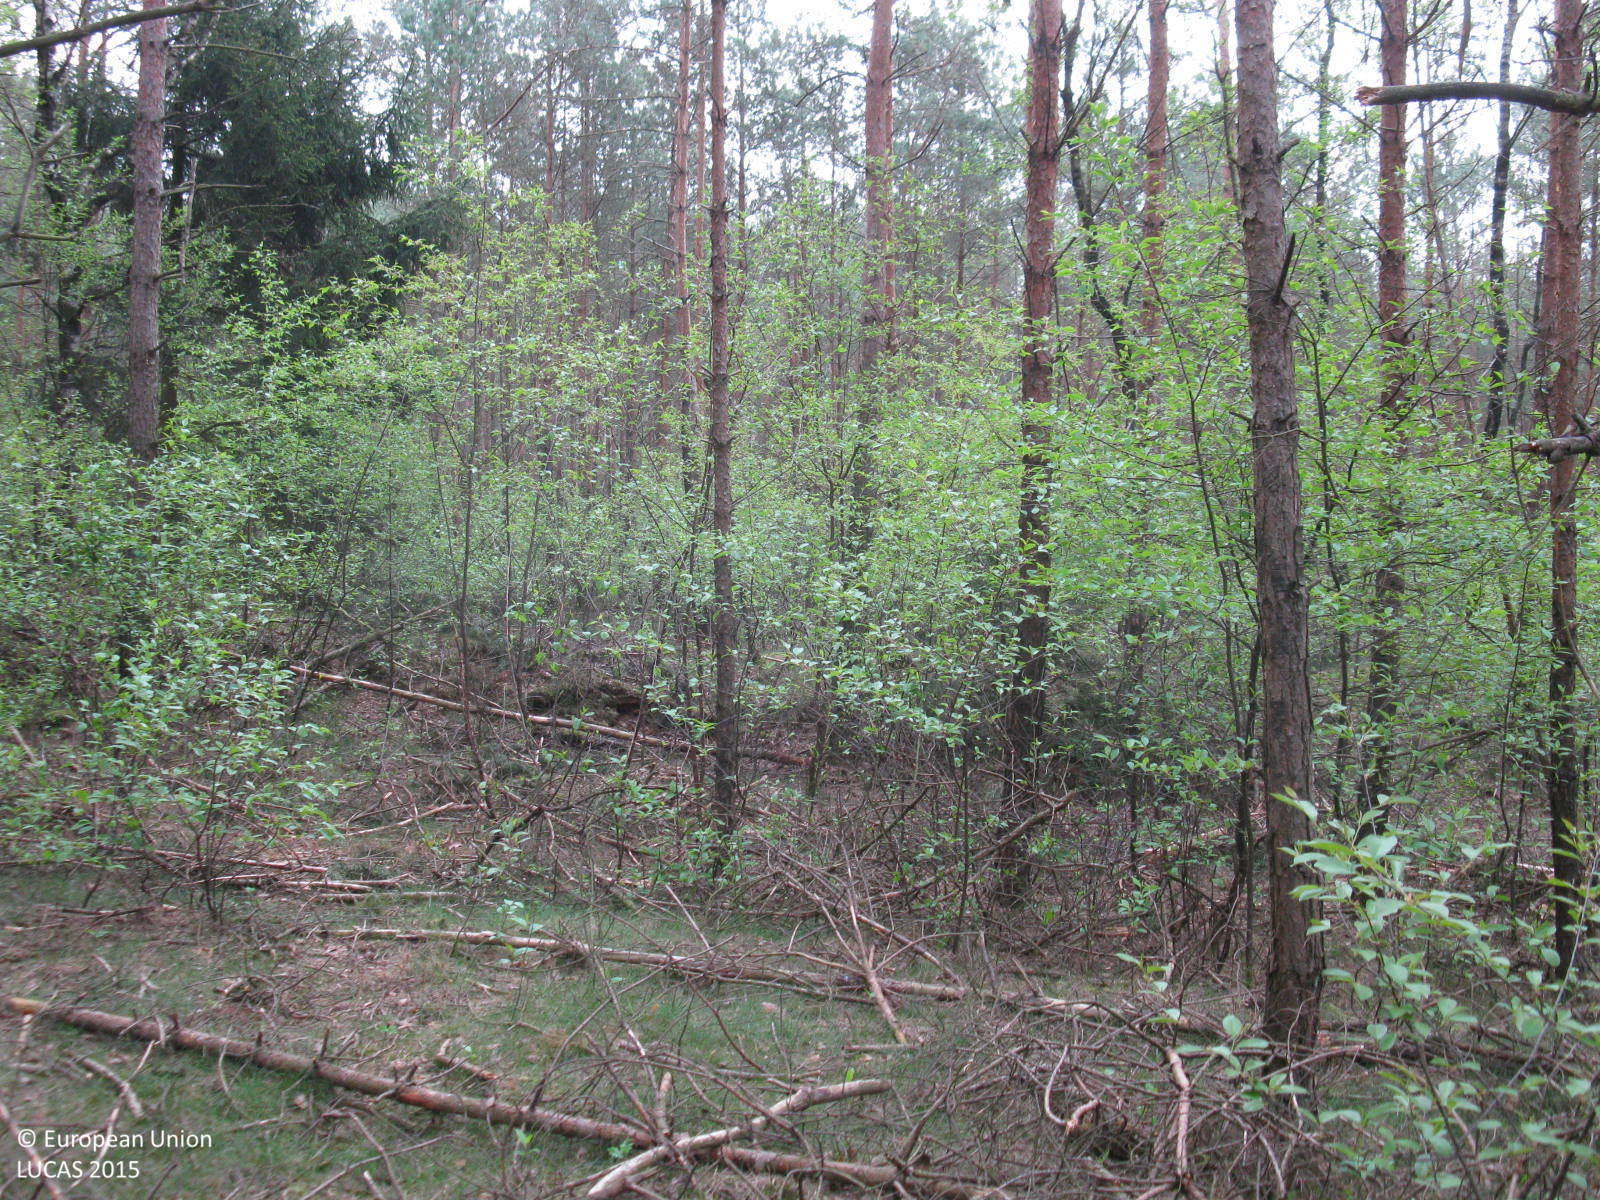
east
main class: Woodland
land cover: Pine dominated coniferous woodland
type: hemiboreal forest and nemoral coniferous forest and mixed broadleaved-coniferous forest
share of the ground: > 75 %
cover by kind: coniferous forest trees 85 %, shrubs 10 %, herbaceous plants 5 %
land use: Forestry
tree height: > 5 m
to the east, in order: Pine dominated coniferous woodland
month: May
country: DE
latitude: 52.9343
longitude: 7.9028
